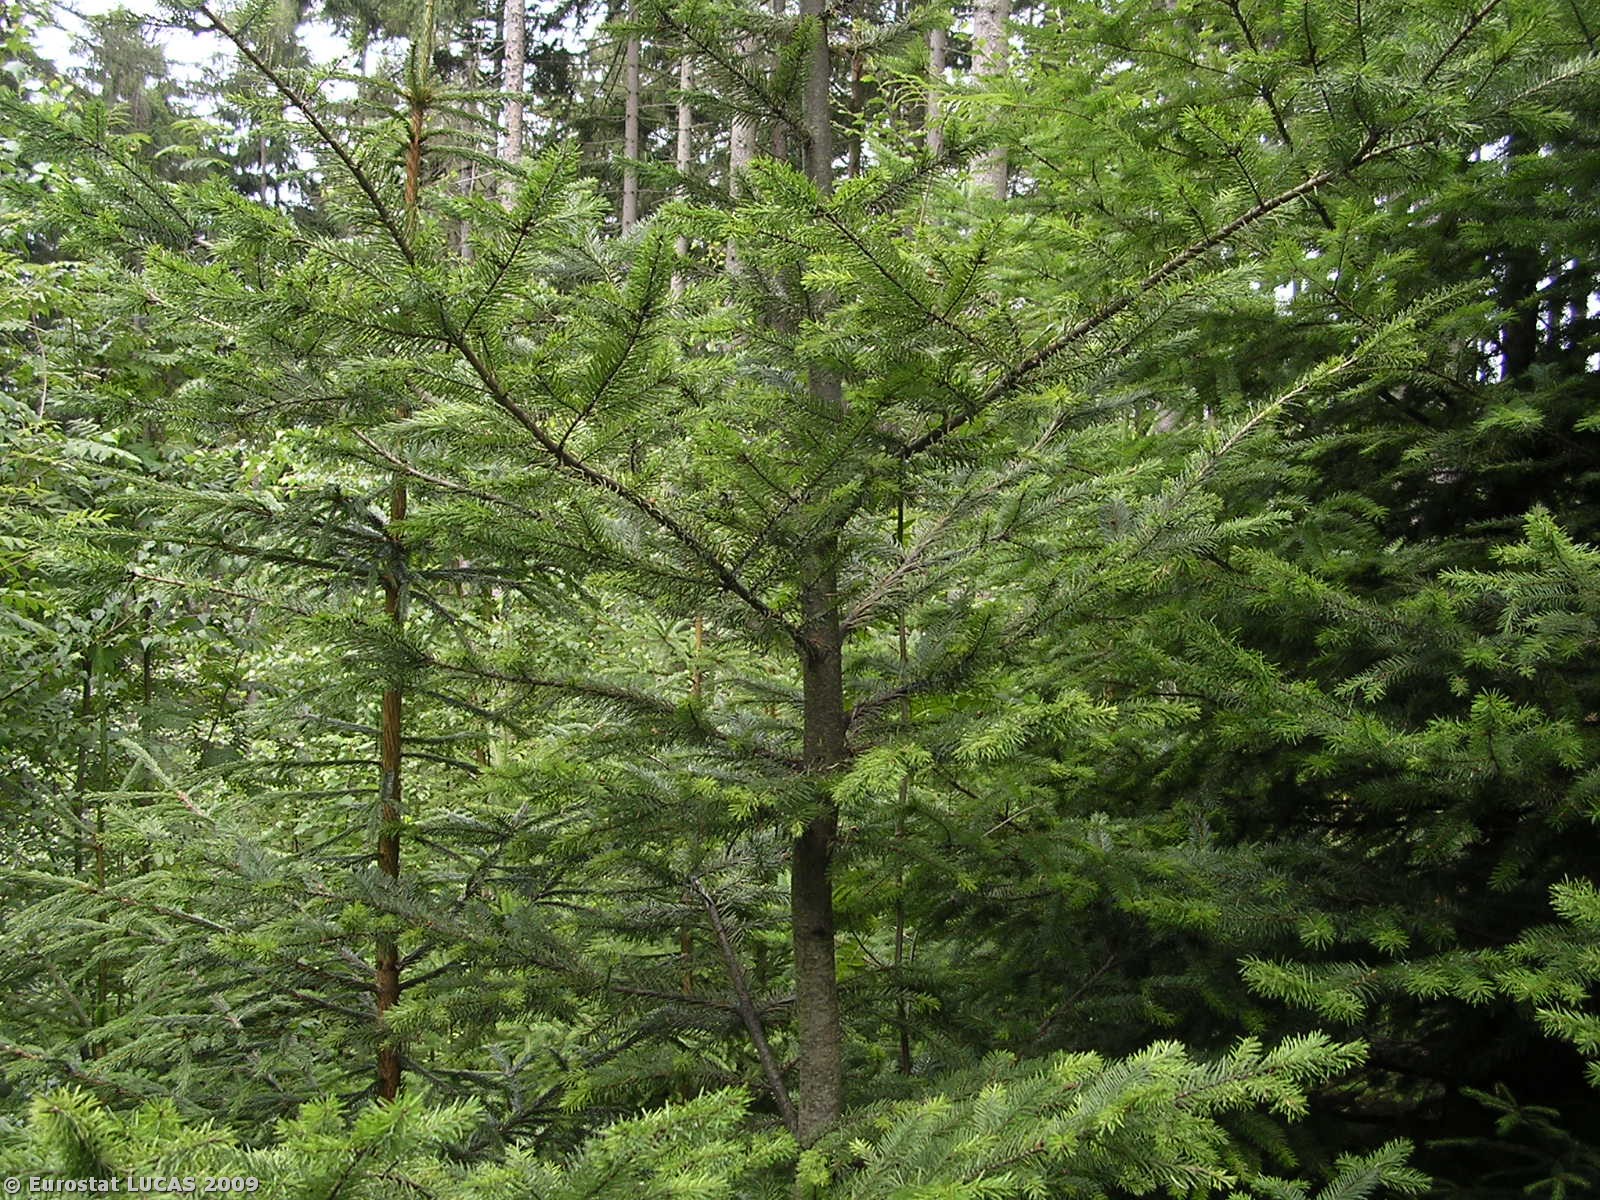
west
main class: Woodland
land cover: Mixed woodland
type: hemiboreal forest and nemoral coniferous forest and mixed broadleaved-coniferous forest
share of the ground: > 75 %
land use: Forestry
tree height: > 5 m
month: July
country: CZ
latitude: 50.7910
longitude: 15.0959
